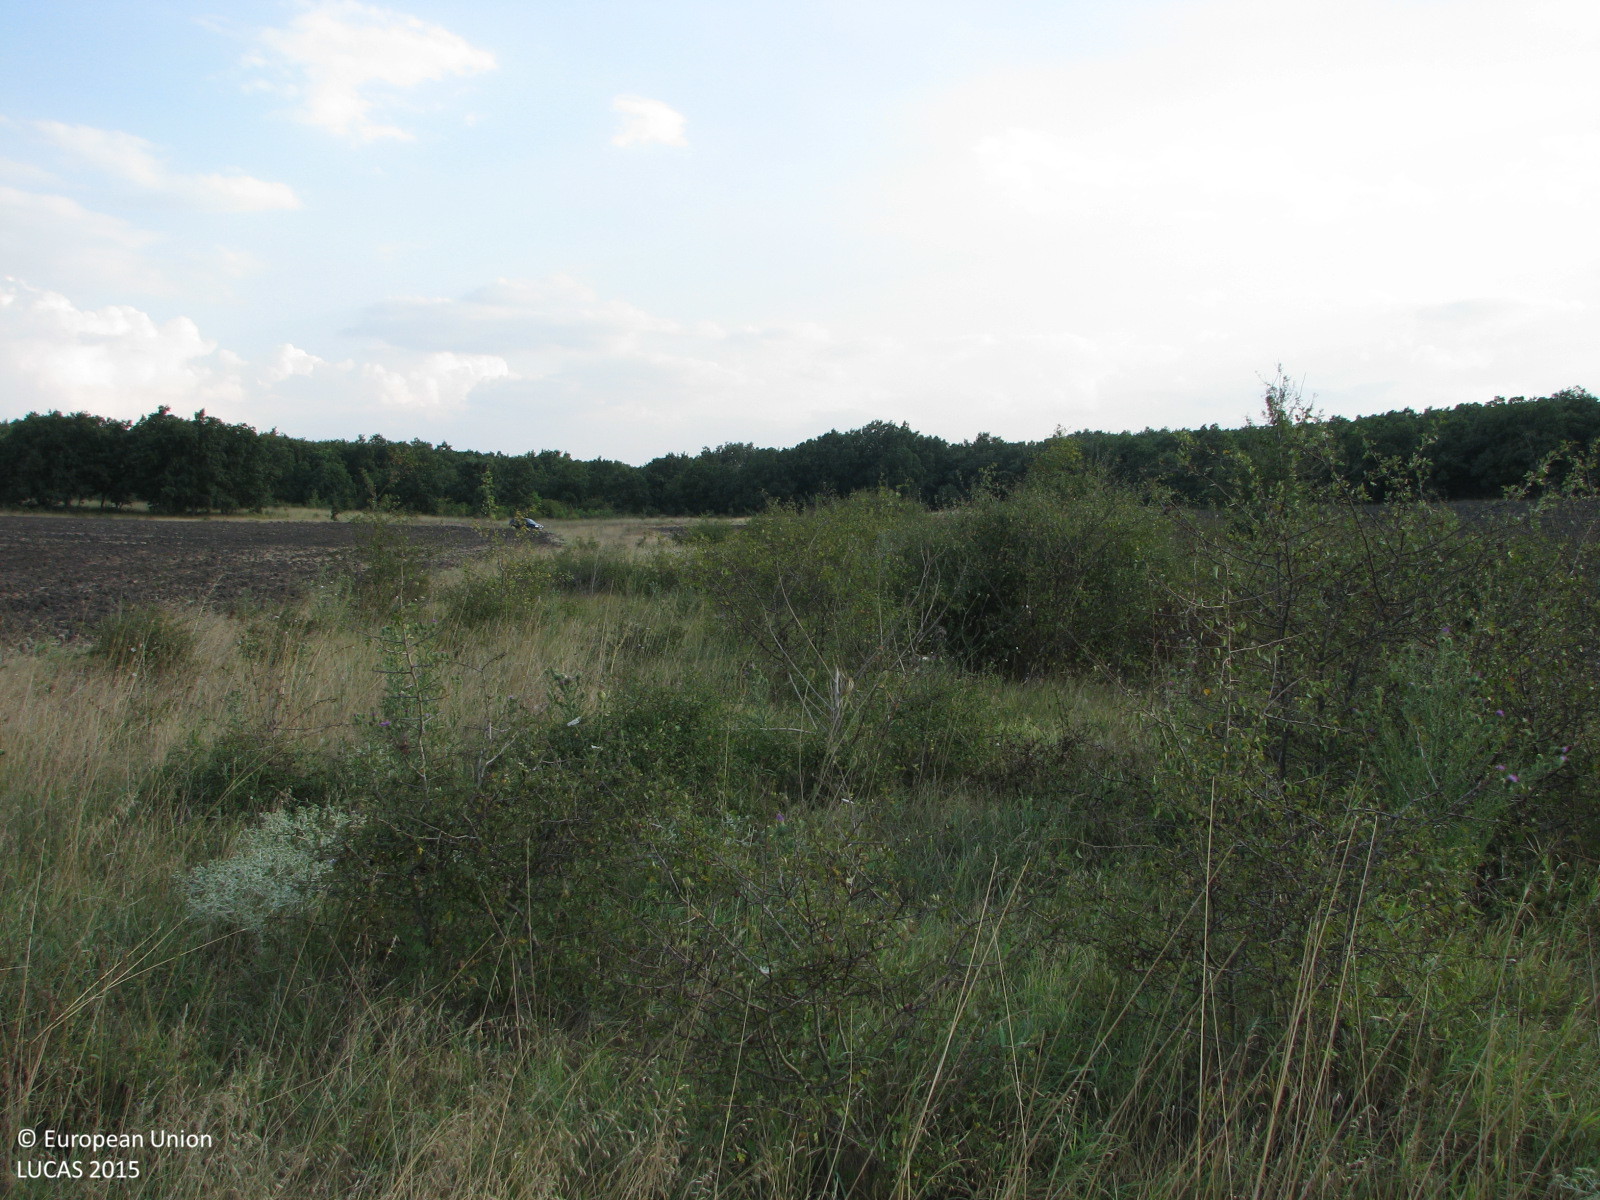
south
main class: Grassland
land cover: Grassland with sparse tree/shrub cover
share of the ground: > 75 %
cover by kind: herbaceous plants 85 %, shrubs 10 %, broadleaved forest trees 5 %
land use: Abandoned areas
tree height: < 5 m
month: August
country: BG
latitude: 42.1497
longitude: 26.8565
